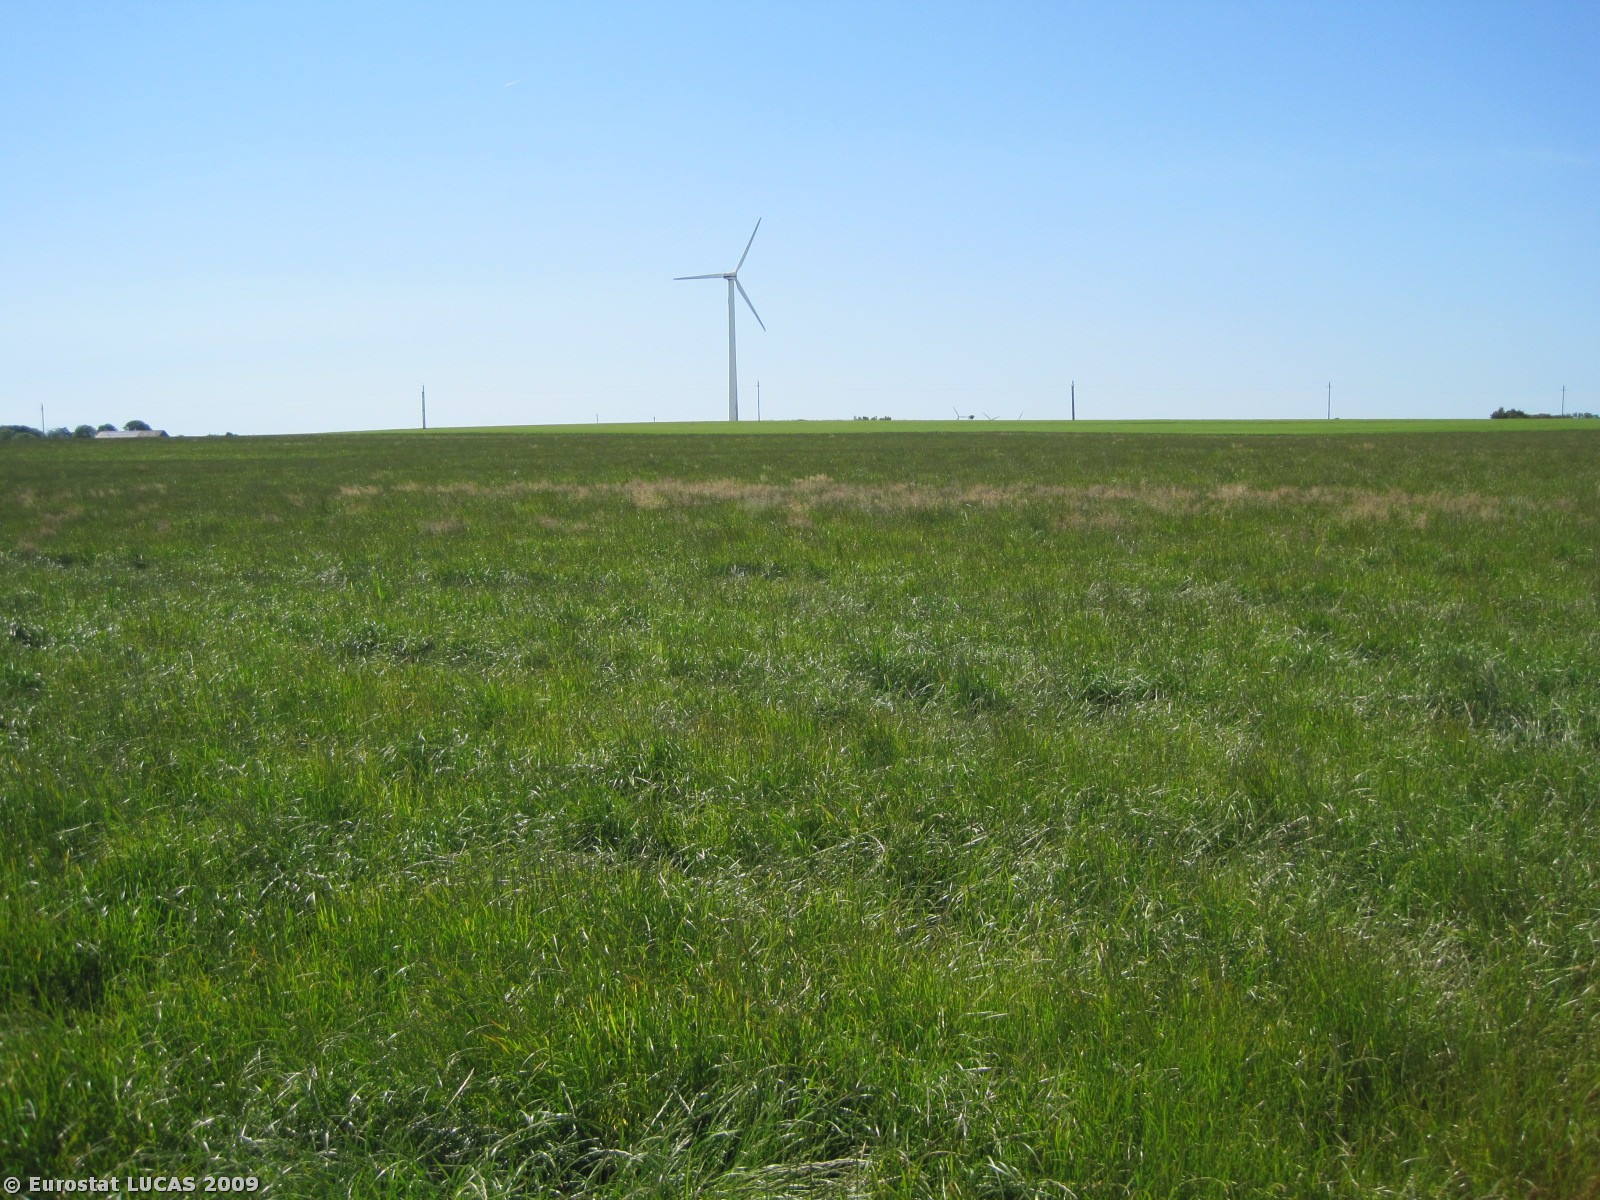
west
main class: Cropland
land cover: Temporary grasslands
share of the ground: > 75 %
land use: Agriculture (excluding fallow land and kitchen gardens)
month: June
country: DK
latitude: 56.6146
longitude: 8.9097
